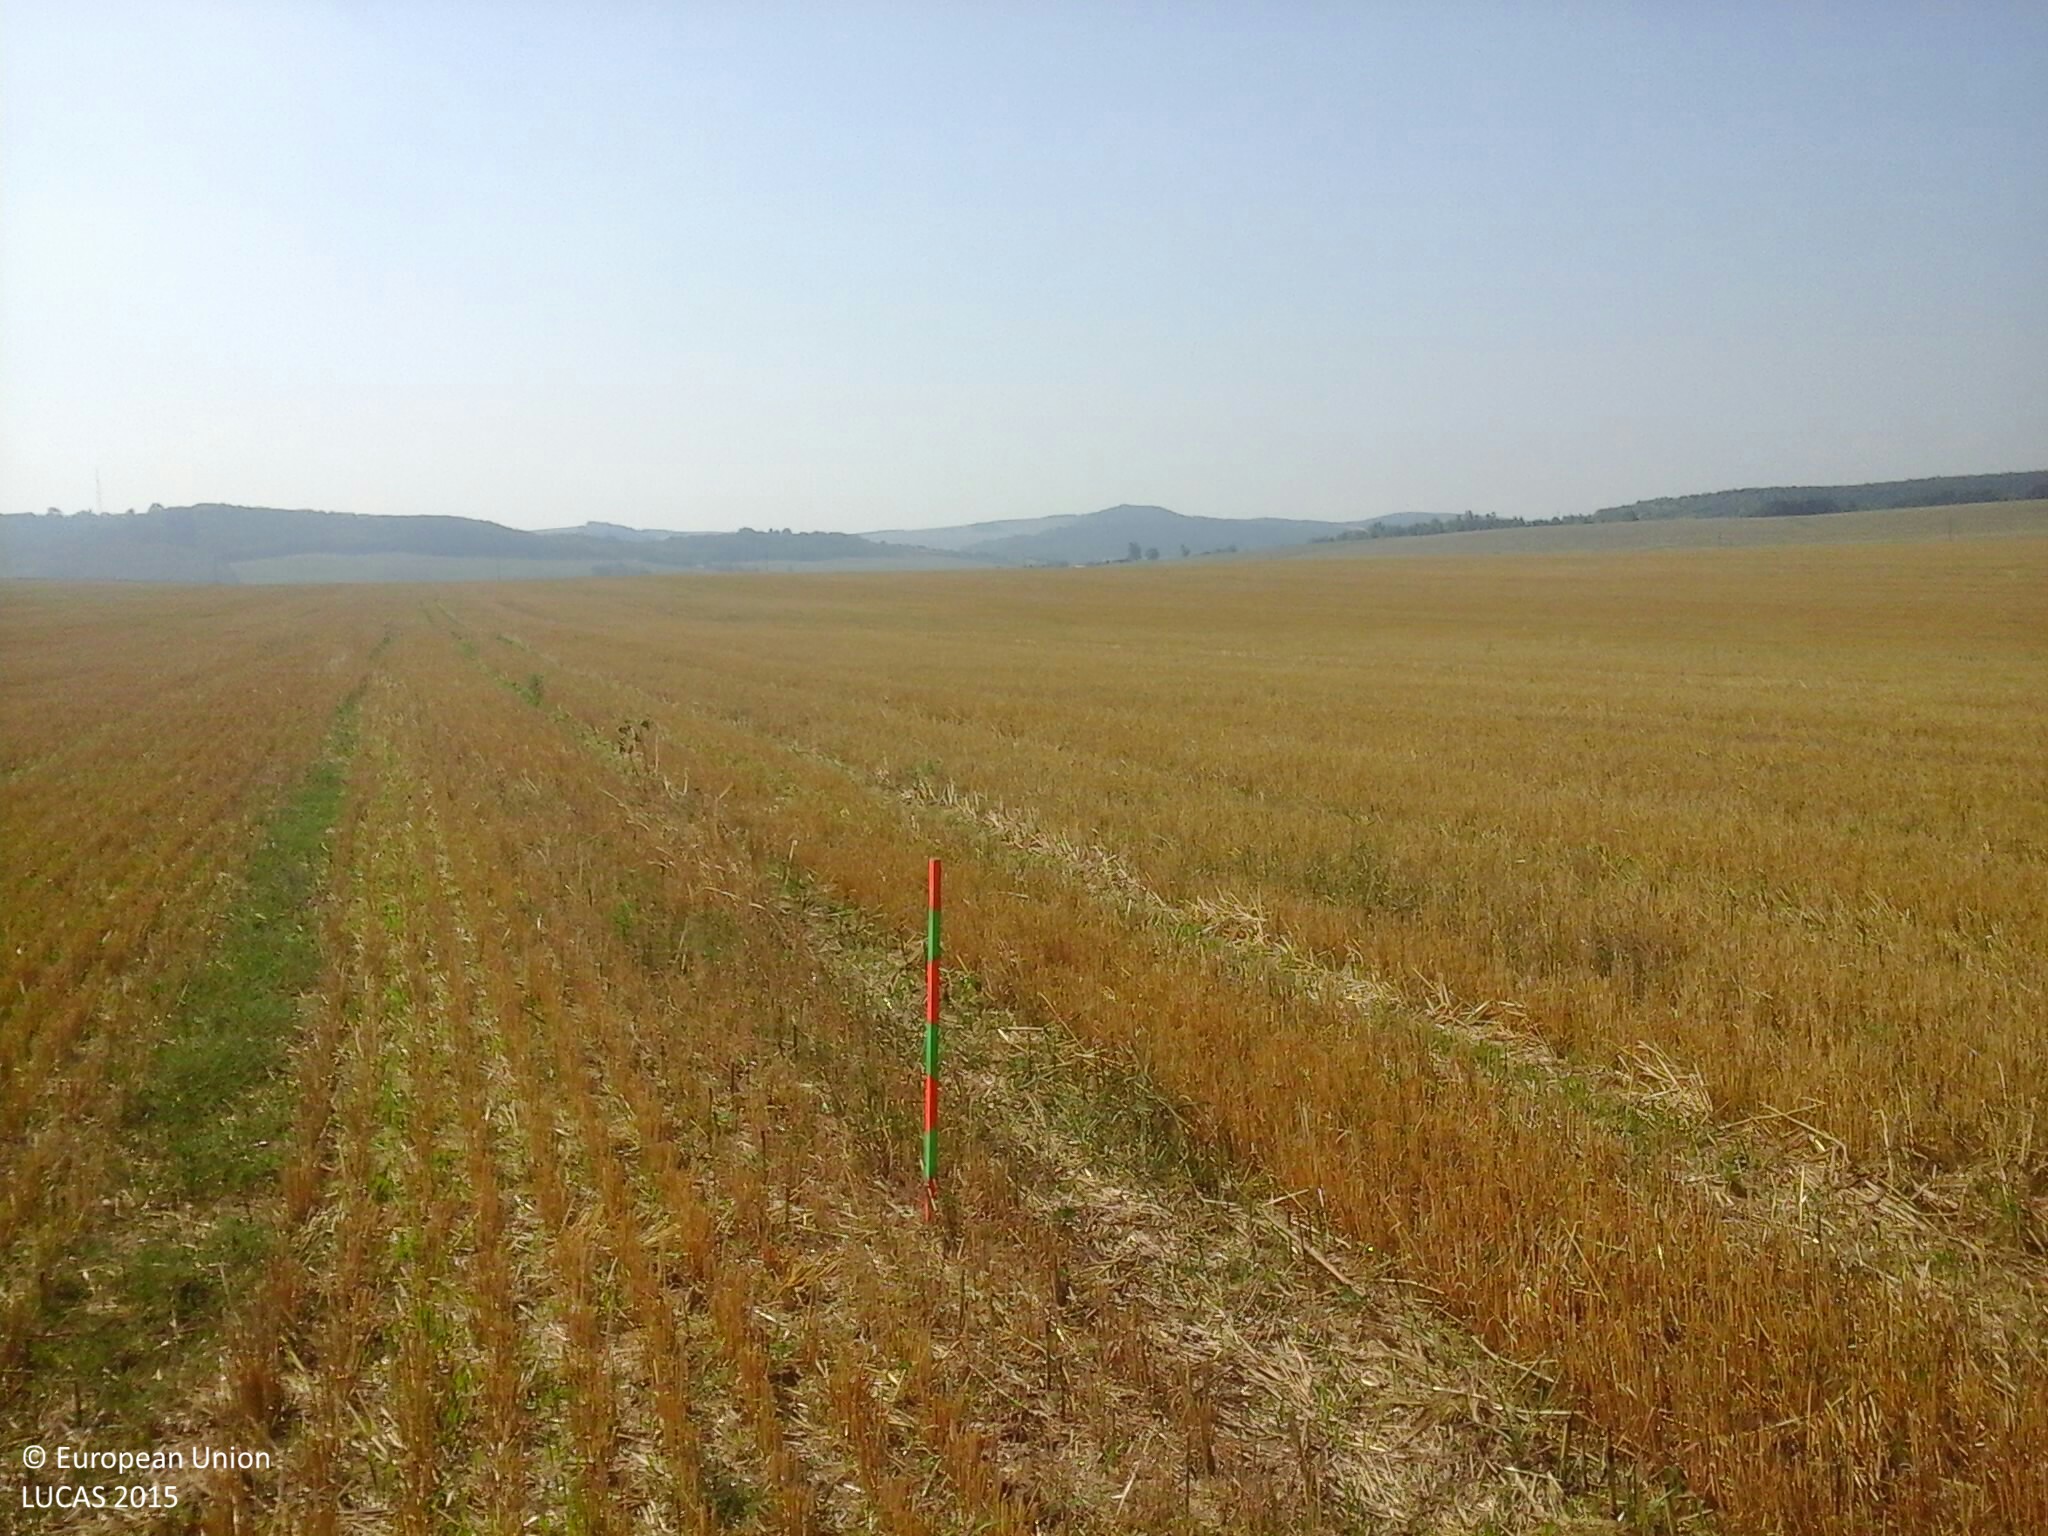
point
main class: Cropland
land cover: Barley
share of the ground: 10 - 25 %
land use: Agriculture (excluding fallow land and kitchen gardens)
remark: Harvested field
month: August
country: HU
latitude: 46.8279
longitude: 18.0184
